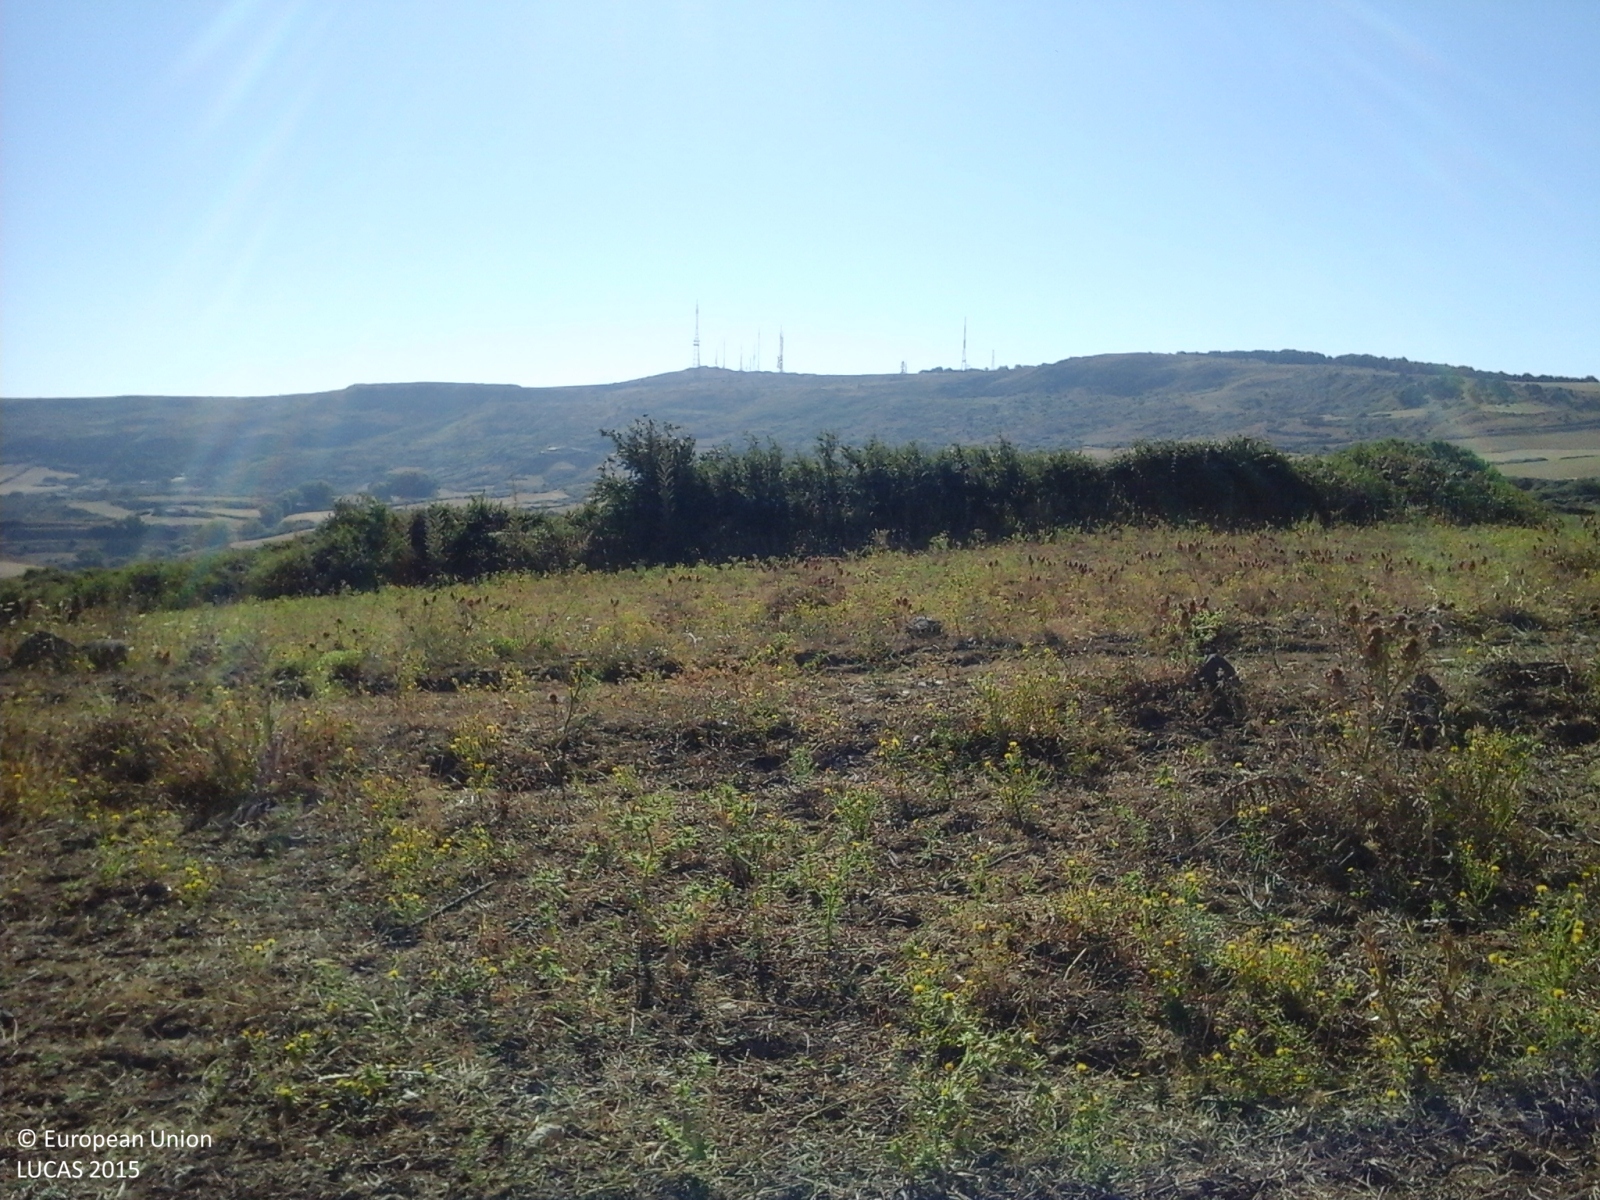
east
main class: Cropland
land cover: Mixed cereals for fodder
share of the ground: > 75 %
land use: Agriculture (excluding fallow land and kitchen gardens)
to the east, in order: Mixed cereals for fodder; Tracks; Mixed cereals for fodder; Shrubland with sparse tree cover; Temporary grasslands; Shrubland with sparse tree cover; Mixed cereals for fodder
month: July
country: IT
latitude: 37.1175
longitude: 14.7912
